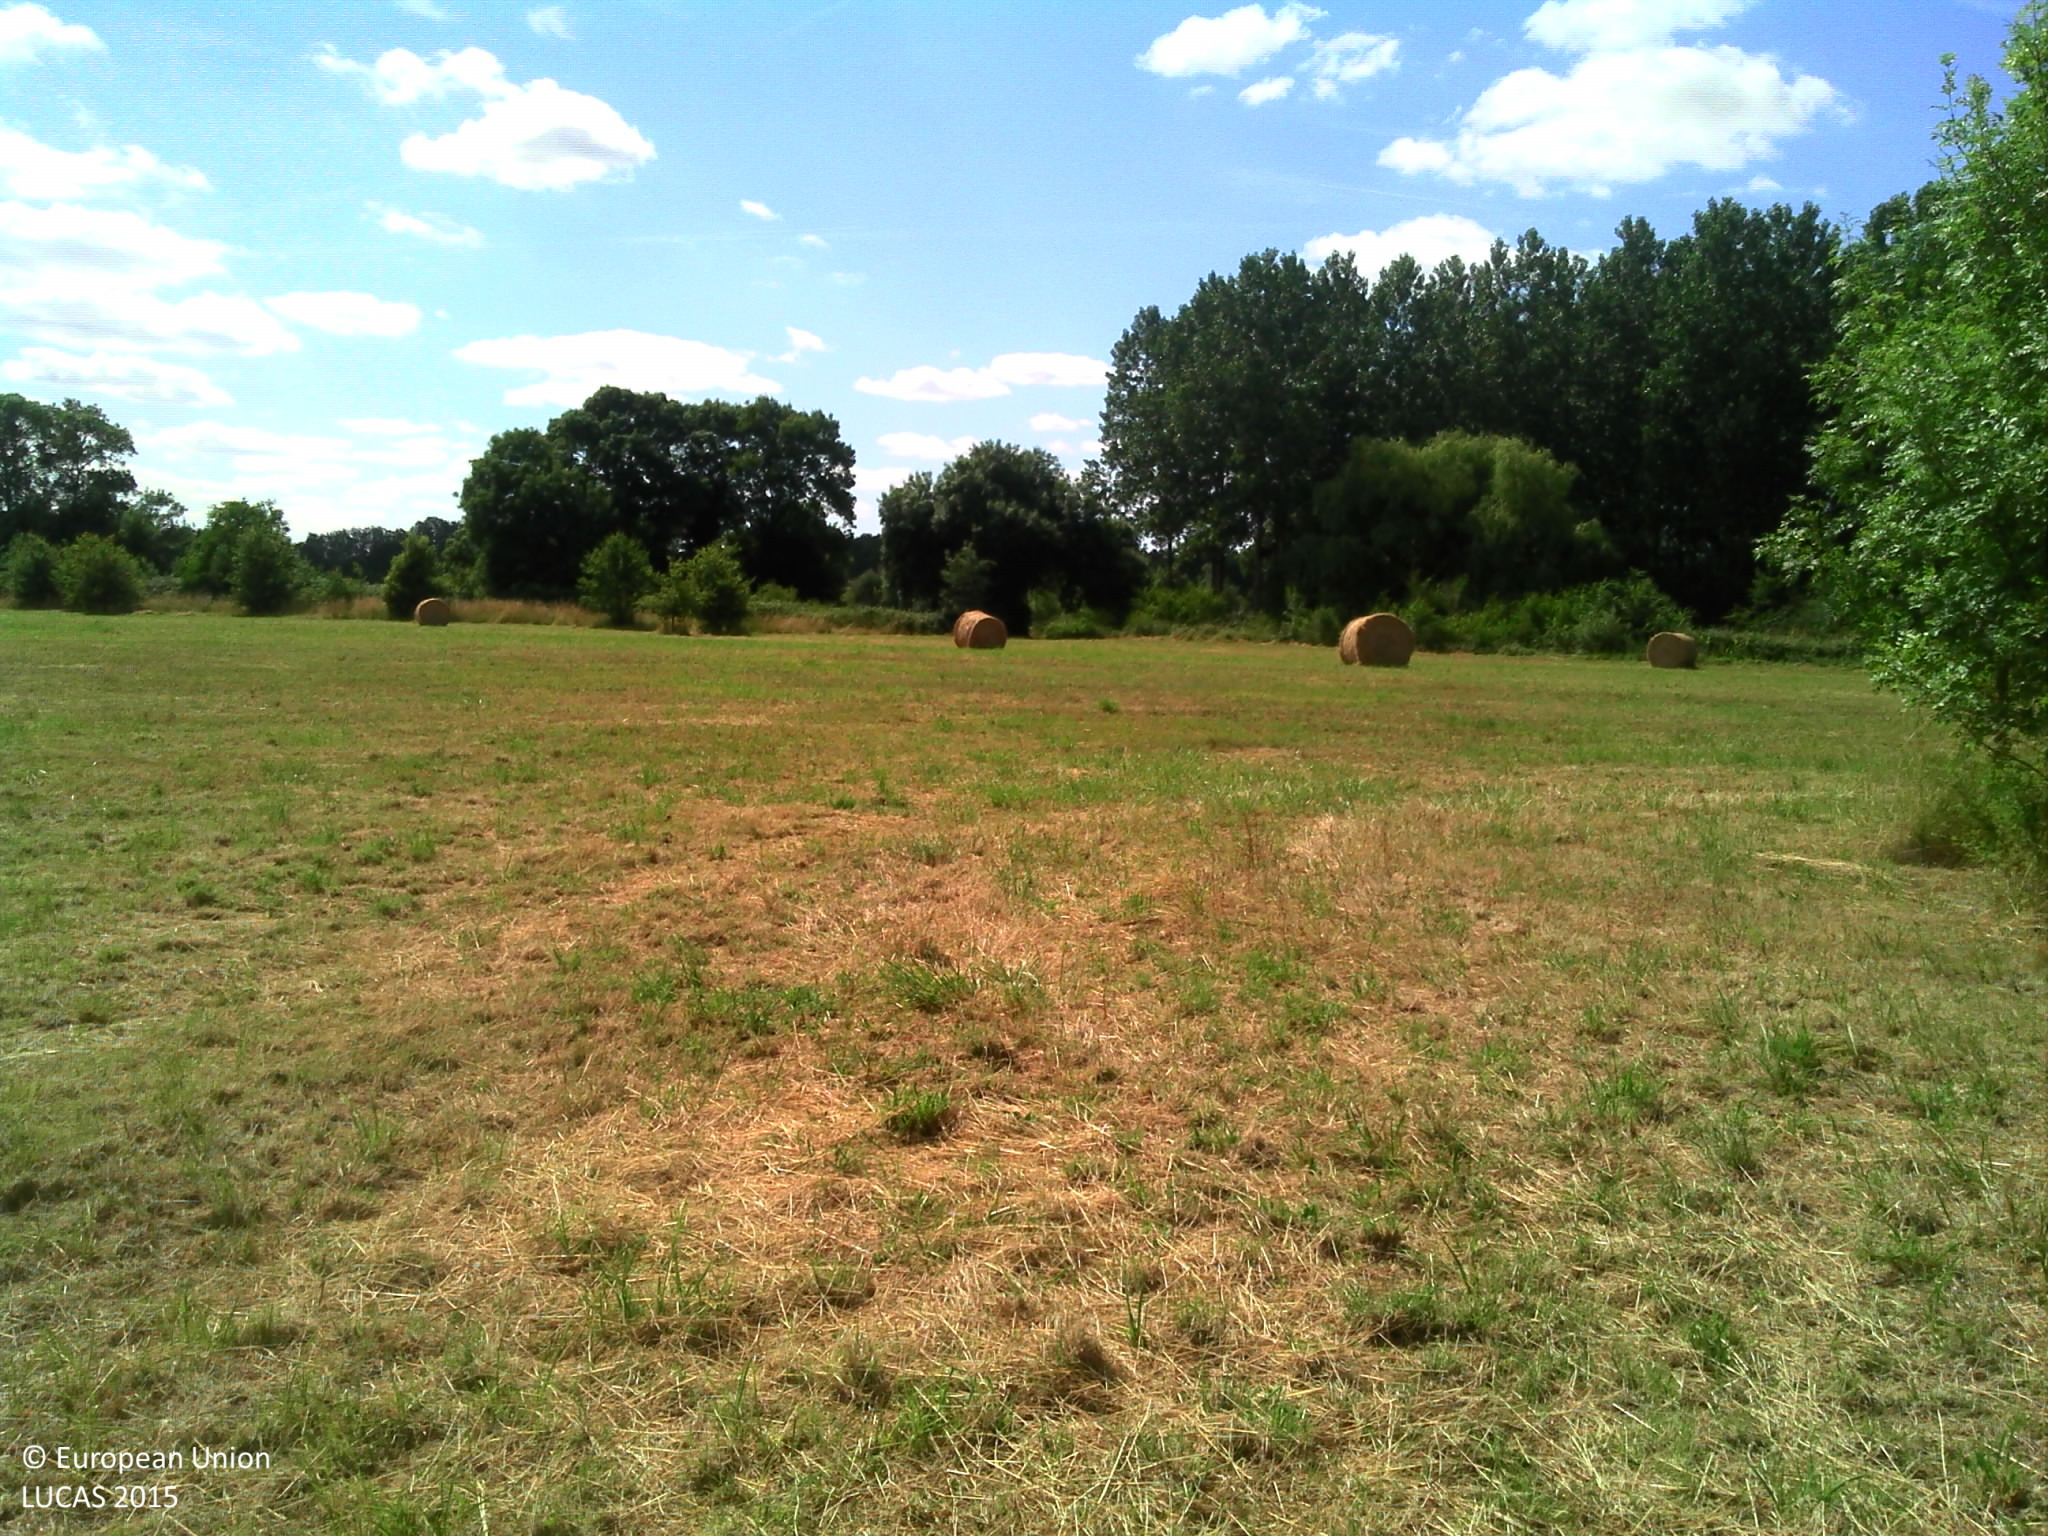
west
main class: Grassland
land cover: Grassland without tree/shrub cover
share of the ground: > 75 %
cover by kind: herbaceous plants 100 %
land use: Agriculture (excluding fallow land and kitchen gardens)
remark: Harvested field
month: June
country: FR
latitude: 47.4869
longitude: 0.3016
